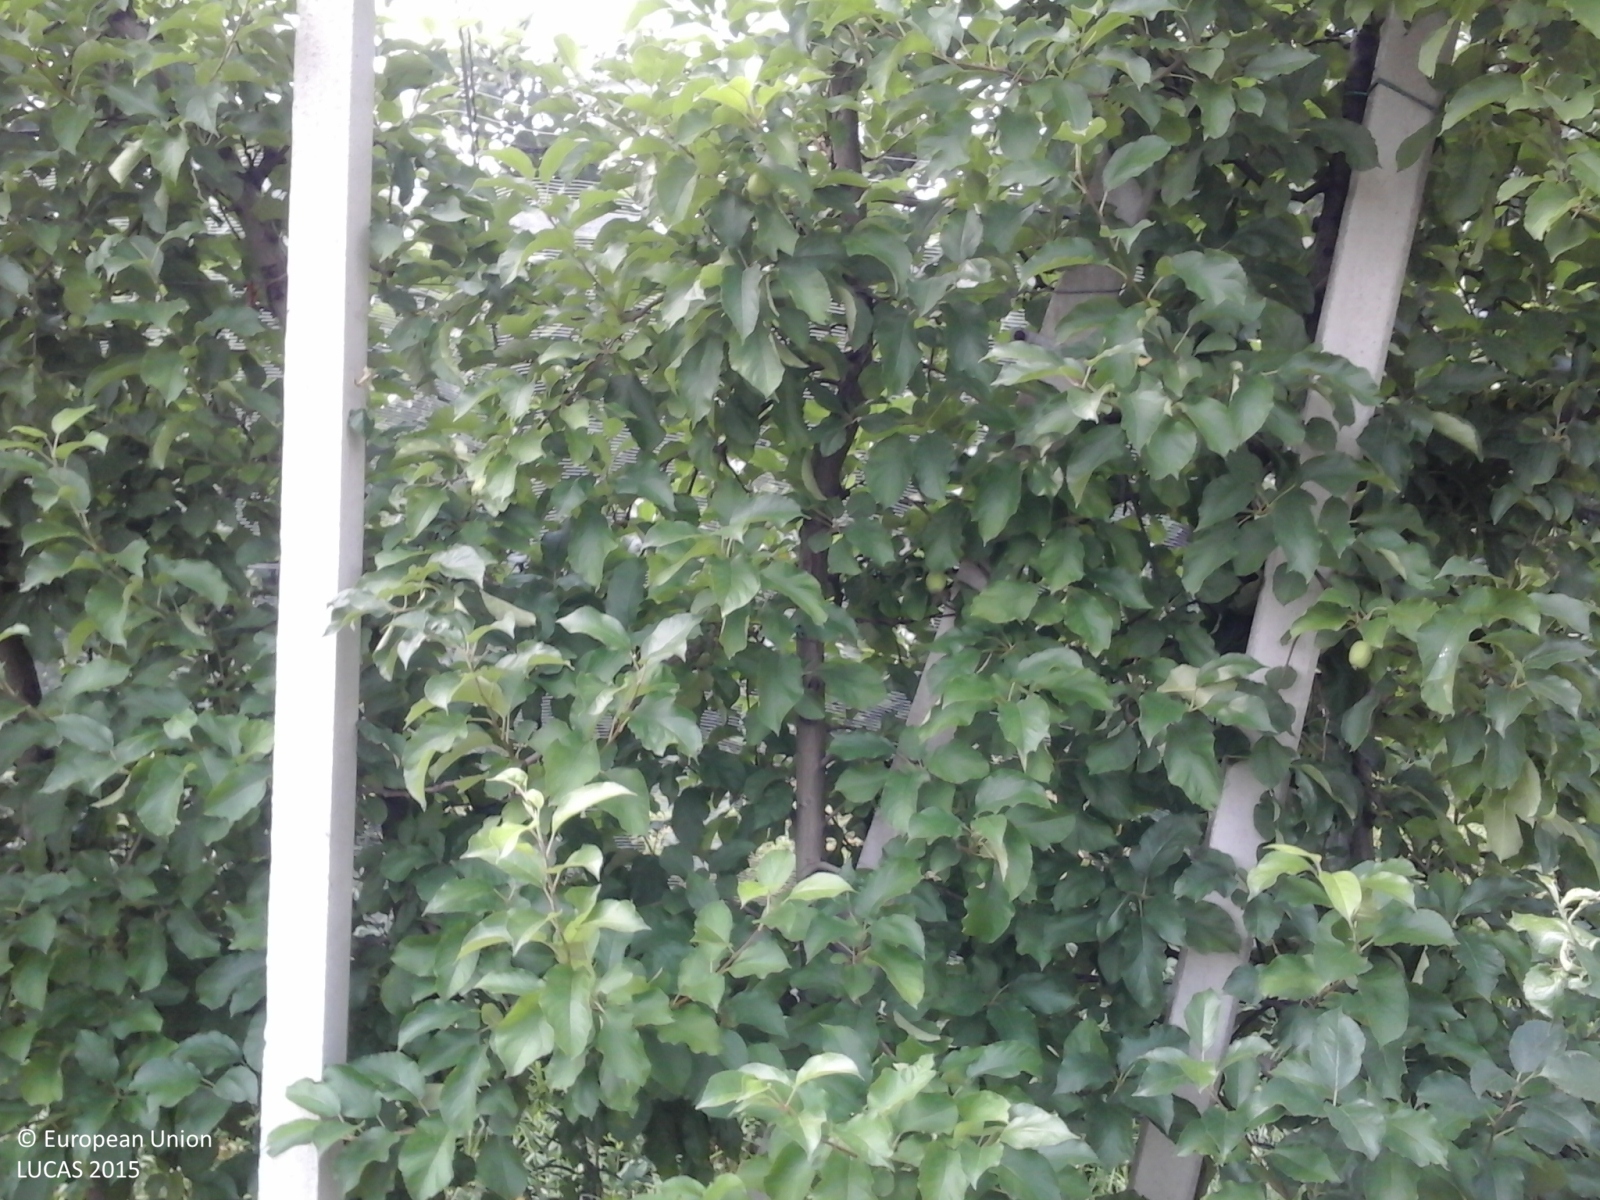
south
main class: Cropland
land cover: Apple fruit
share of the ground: < 10 %
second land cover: Grassland without tree/shrub cover
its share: > 75 %
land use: Agriculture (excluding fallow land and kitchen gardens)
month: June
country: IT
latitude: 45.9673
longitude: 11.0953
